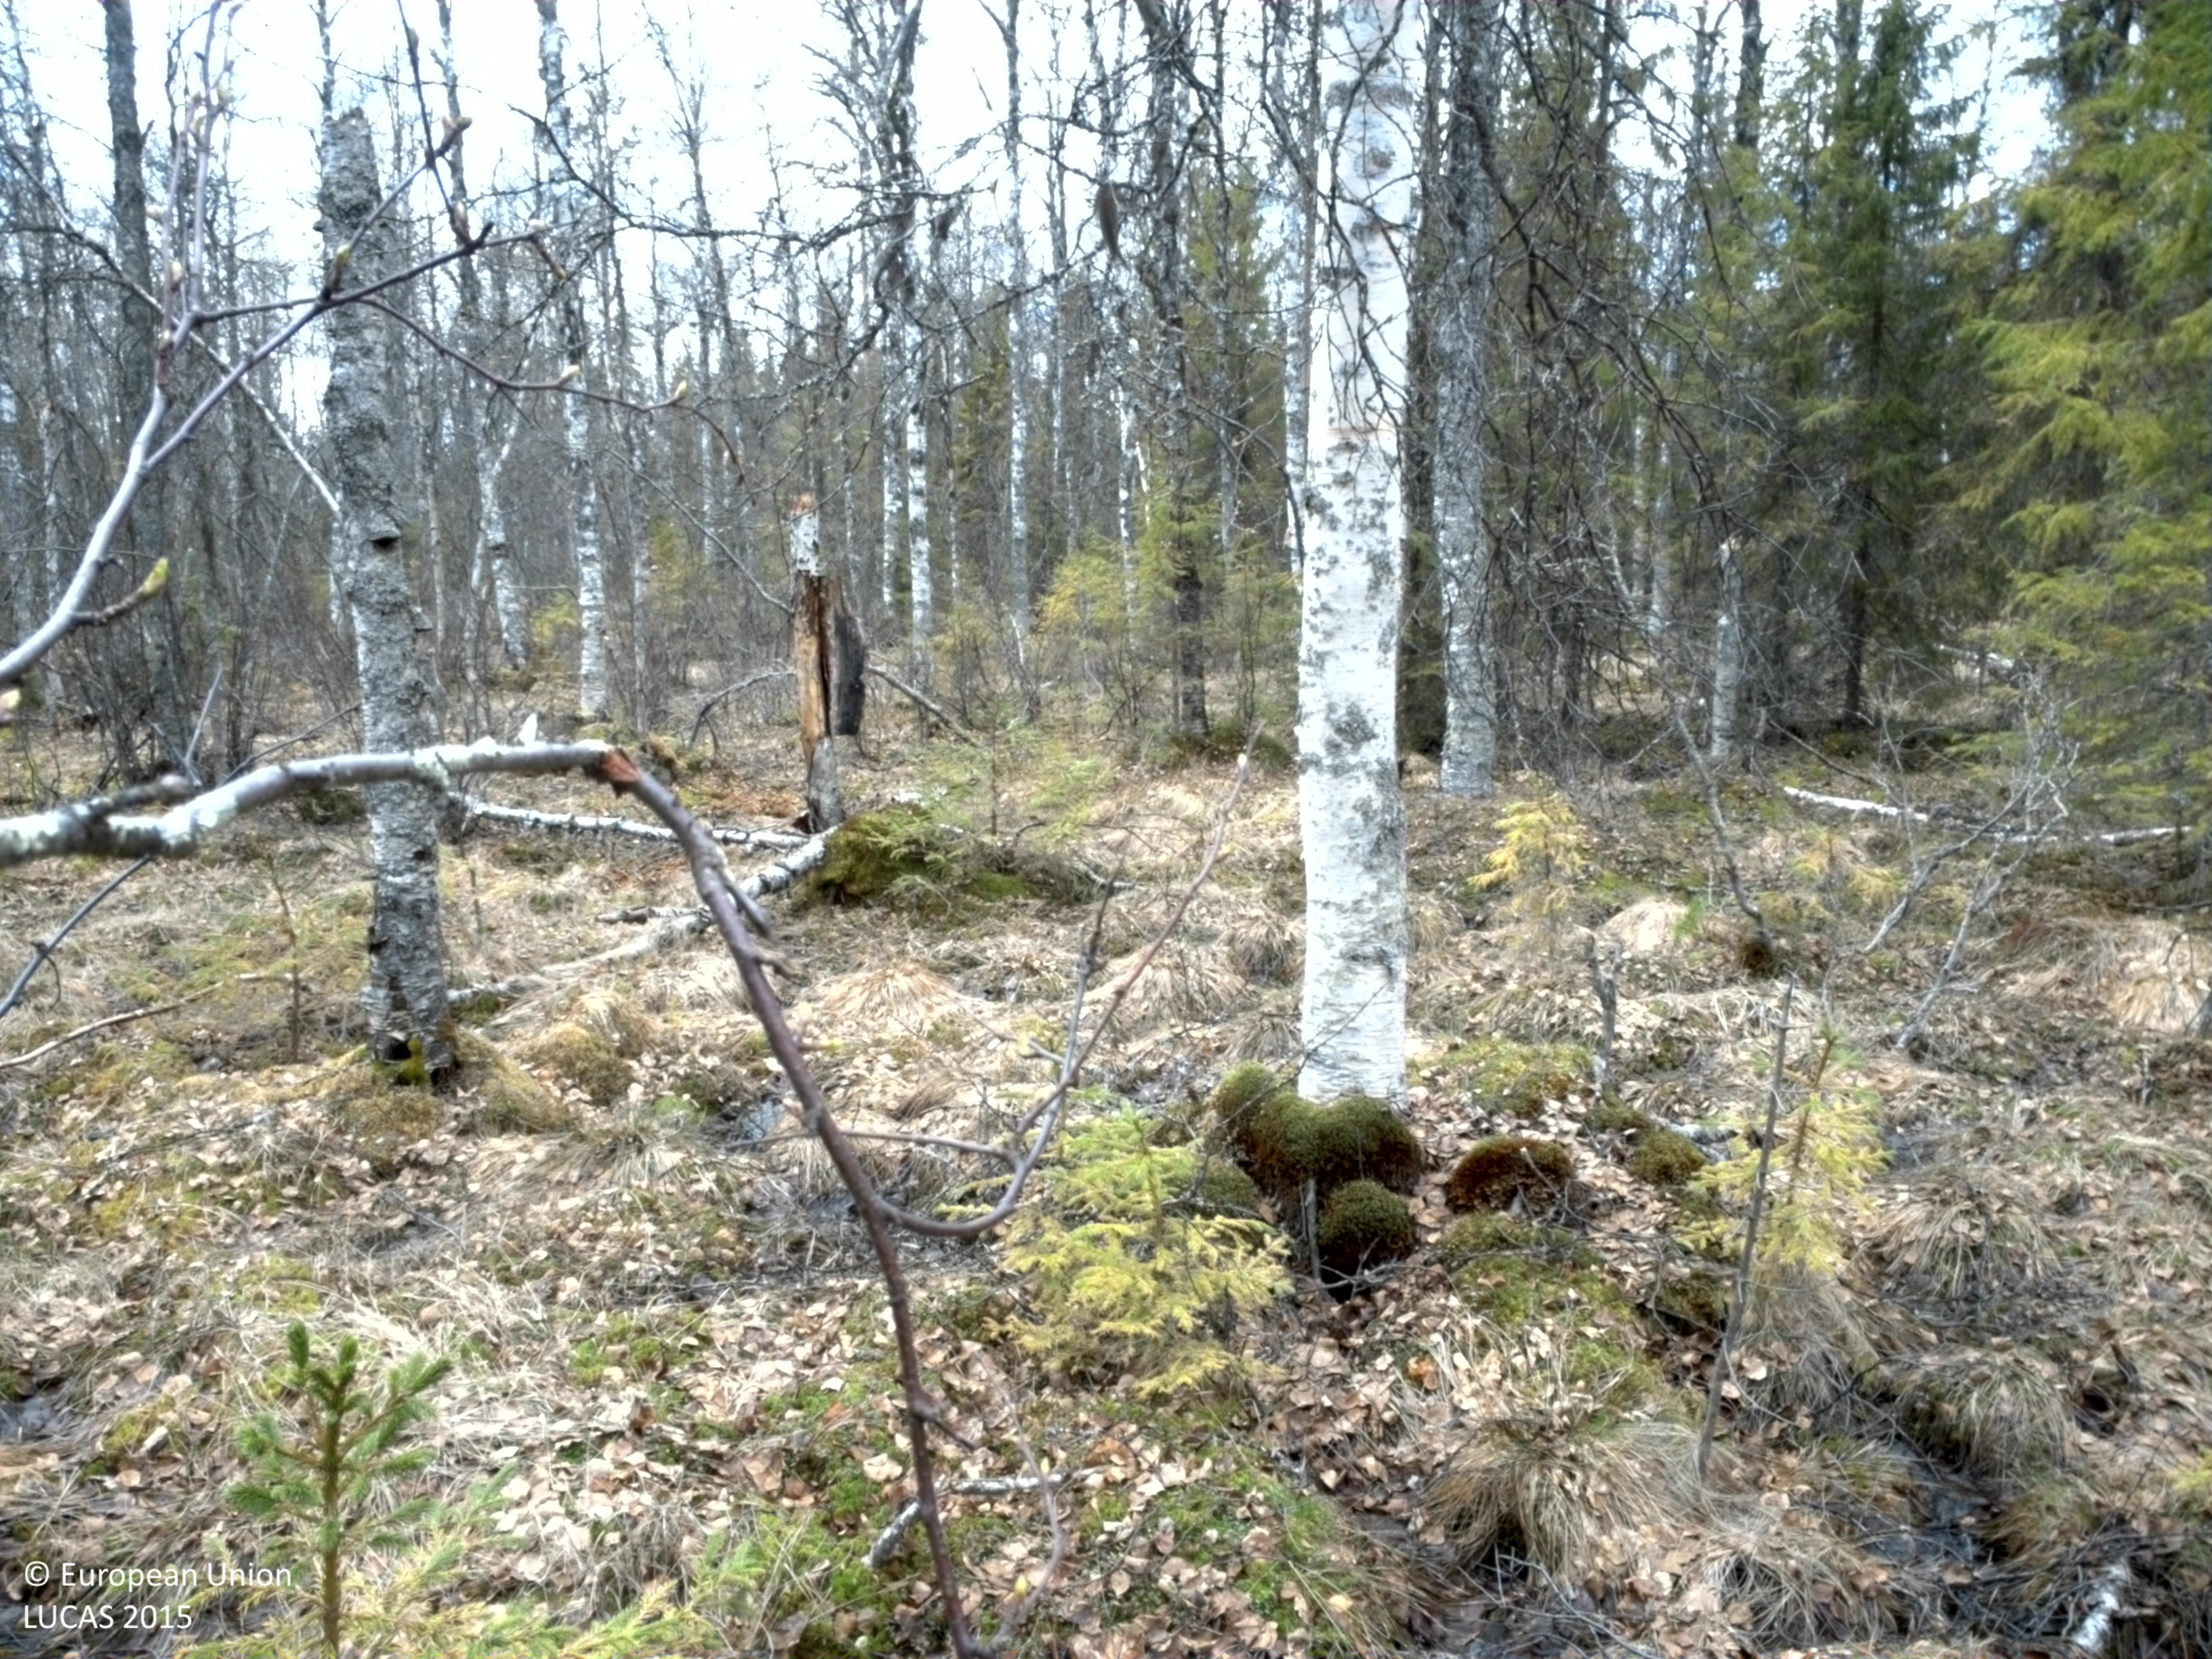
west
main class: Woodland
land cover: Broadleaved woodland
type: hemiboreal forest and nemoral coniferous forest and mixed broadleaved-coniferous forest
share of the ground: > 75 %
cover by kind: broadleaved forest trees 75 %, coniferous forest trees 10 %, herbaceous plants 10 %, lichens and mosses 5 %
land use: Forestry
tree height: > 5 m
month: May
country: SE
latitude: 66.0355
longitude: 23.8295
